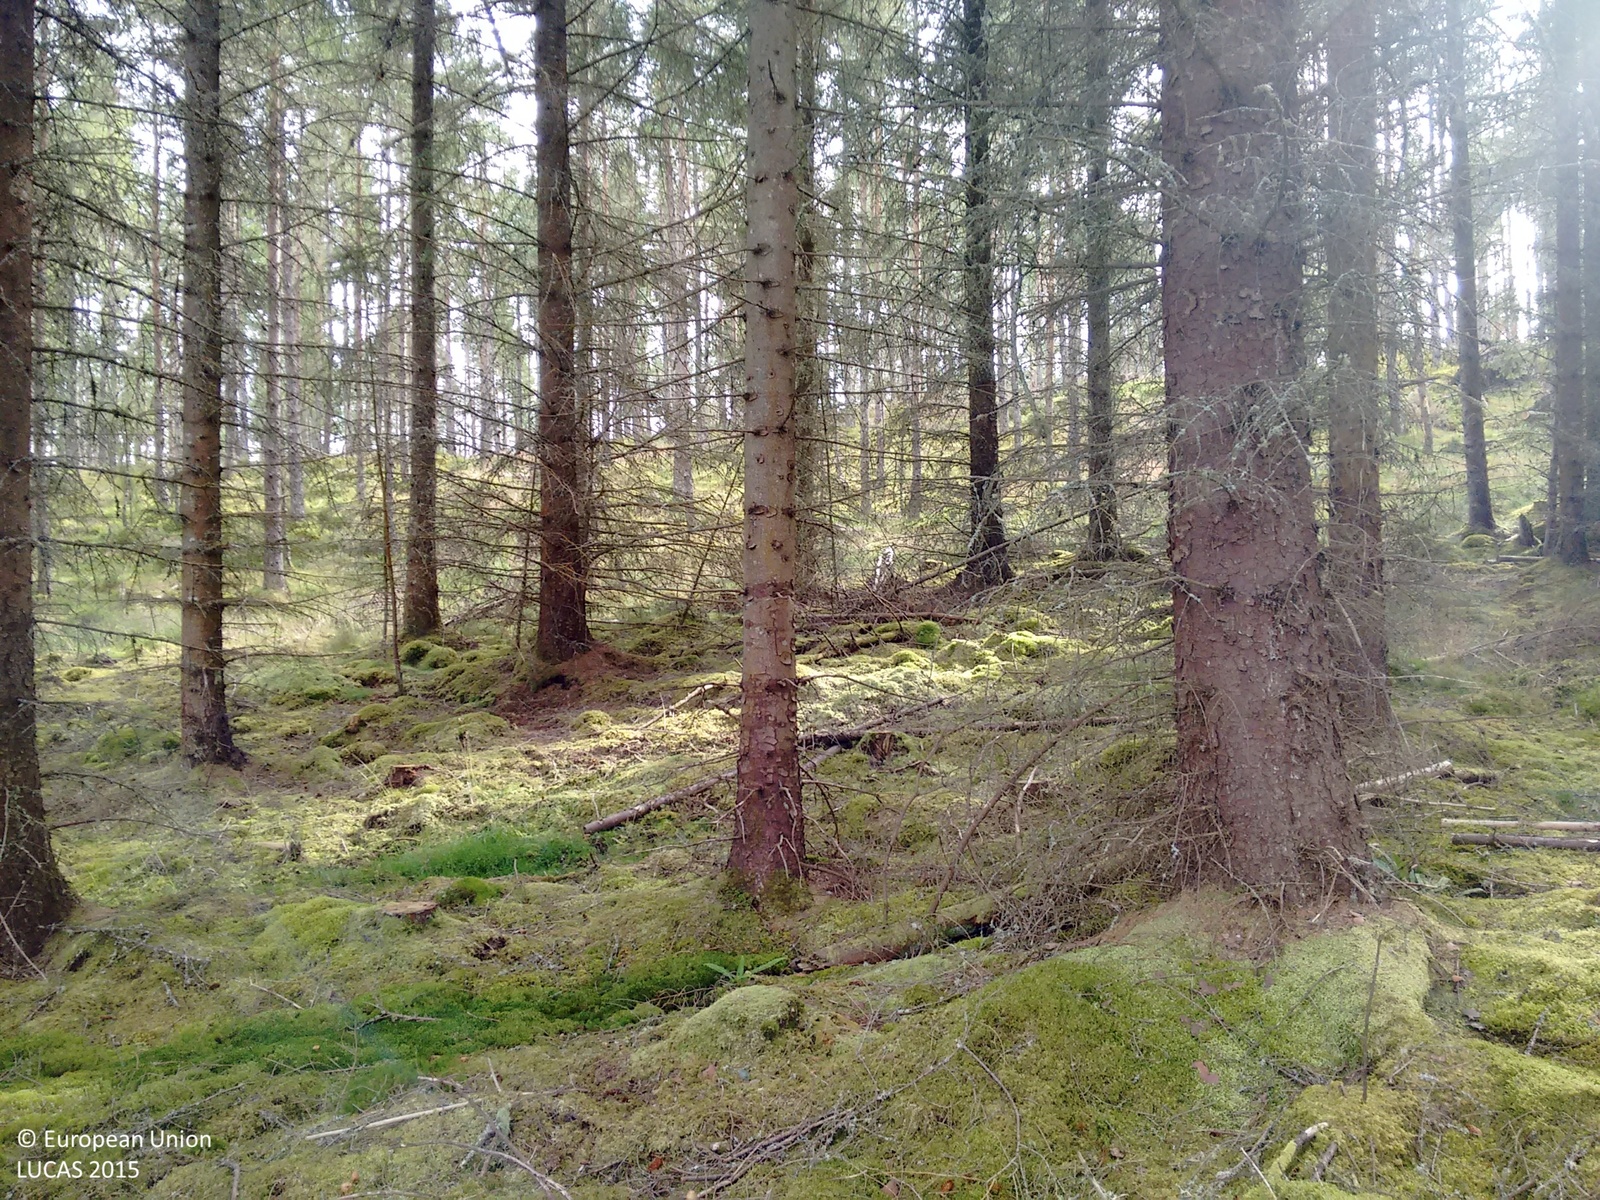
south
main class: Woodland
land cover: Spruce dominated coniferous woodland
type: exotic forest
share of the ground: > 75 %
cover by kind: coniferous forest trees 100 %
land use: Forestry
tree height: > 5 m
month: September
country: GB
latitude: 57.5714
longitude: -4.5204
